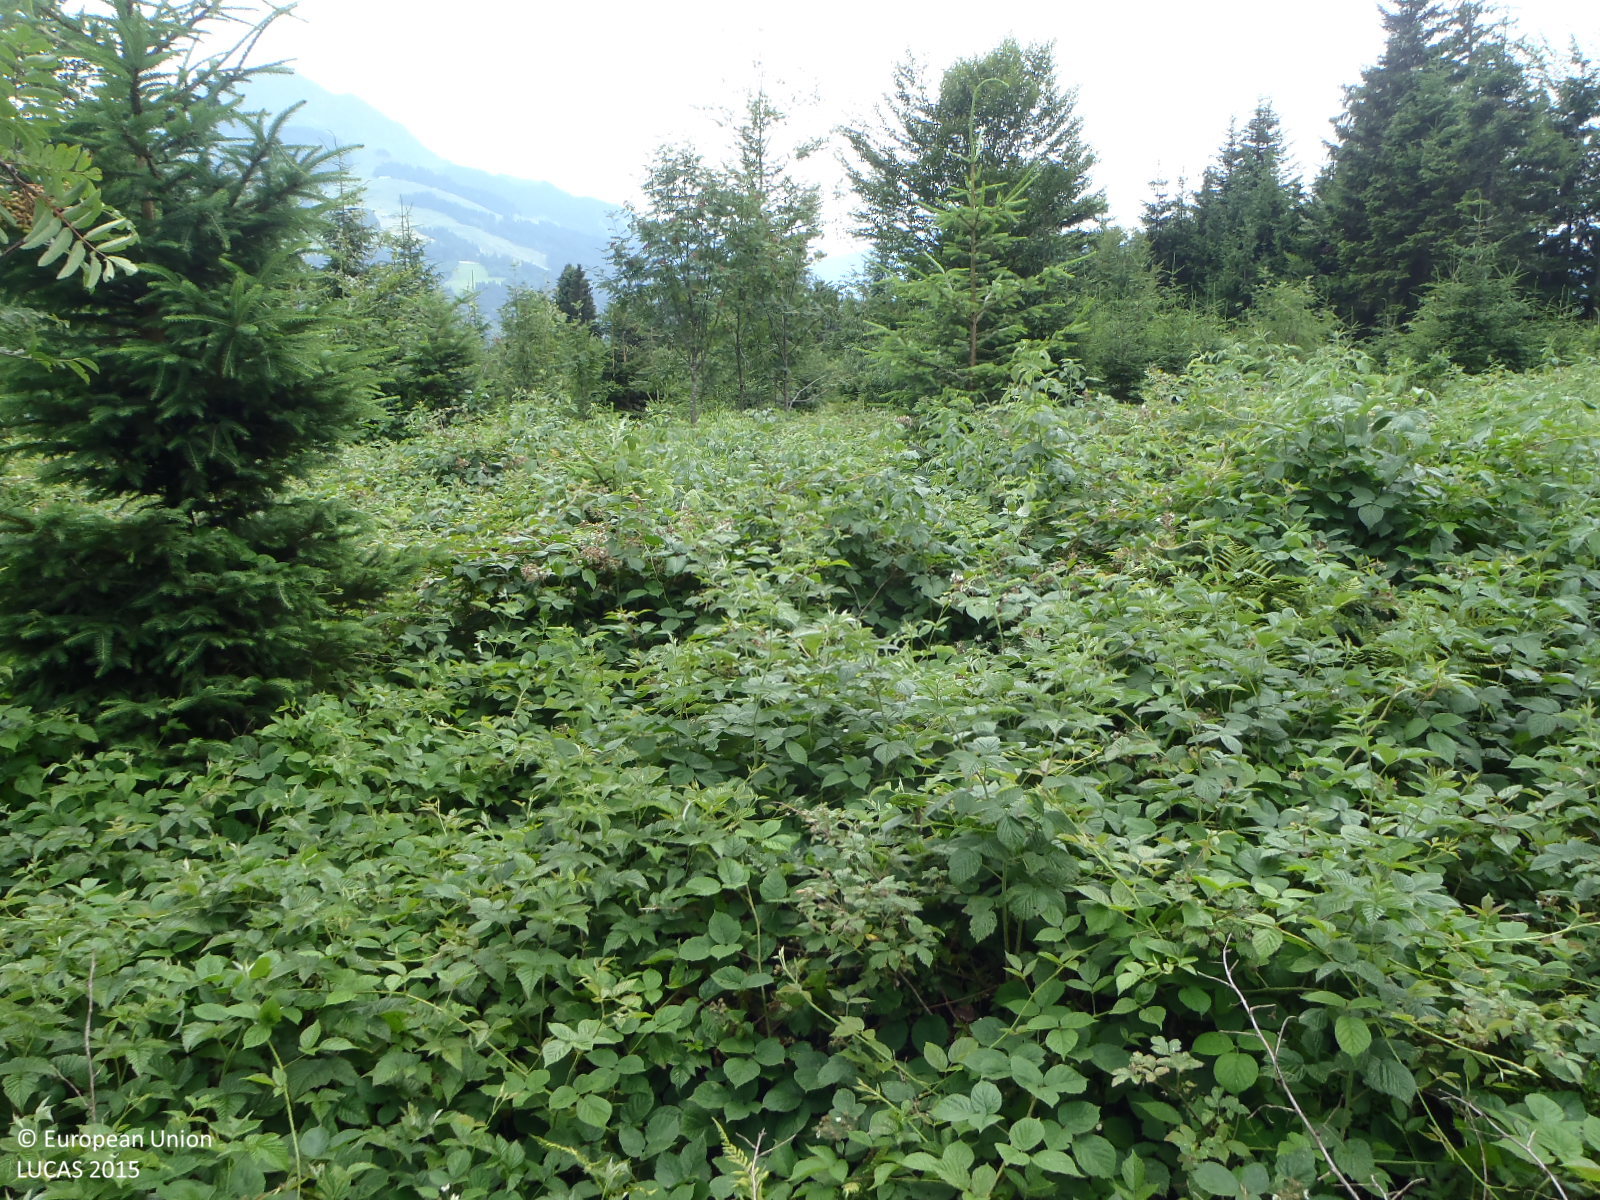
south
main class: Woodland
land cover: Other coniferous woodland
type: alpine coniferous forest
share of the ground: > 75 %
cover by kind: shrubs 55 %, coniferous forest trees 25 %, herbaceous plants 15 %, broadleaved forest trees 5 %
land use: Forestry
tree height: < 5 m
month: July
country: AT
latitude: 47.5312
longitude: 12.4026
